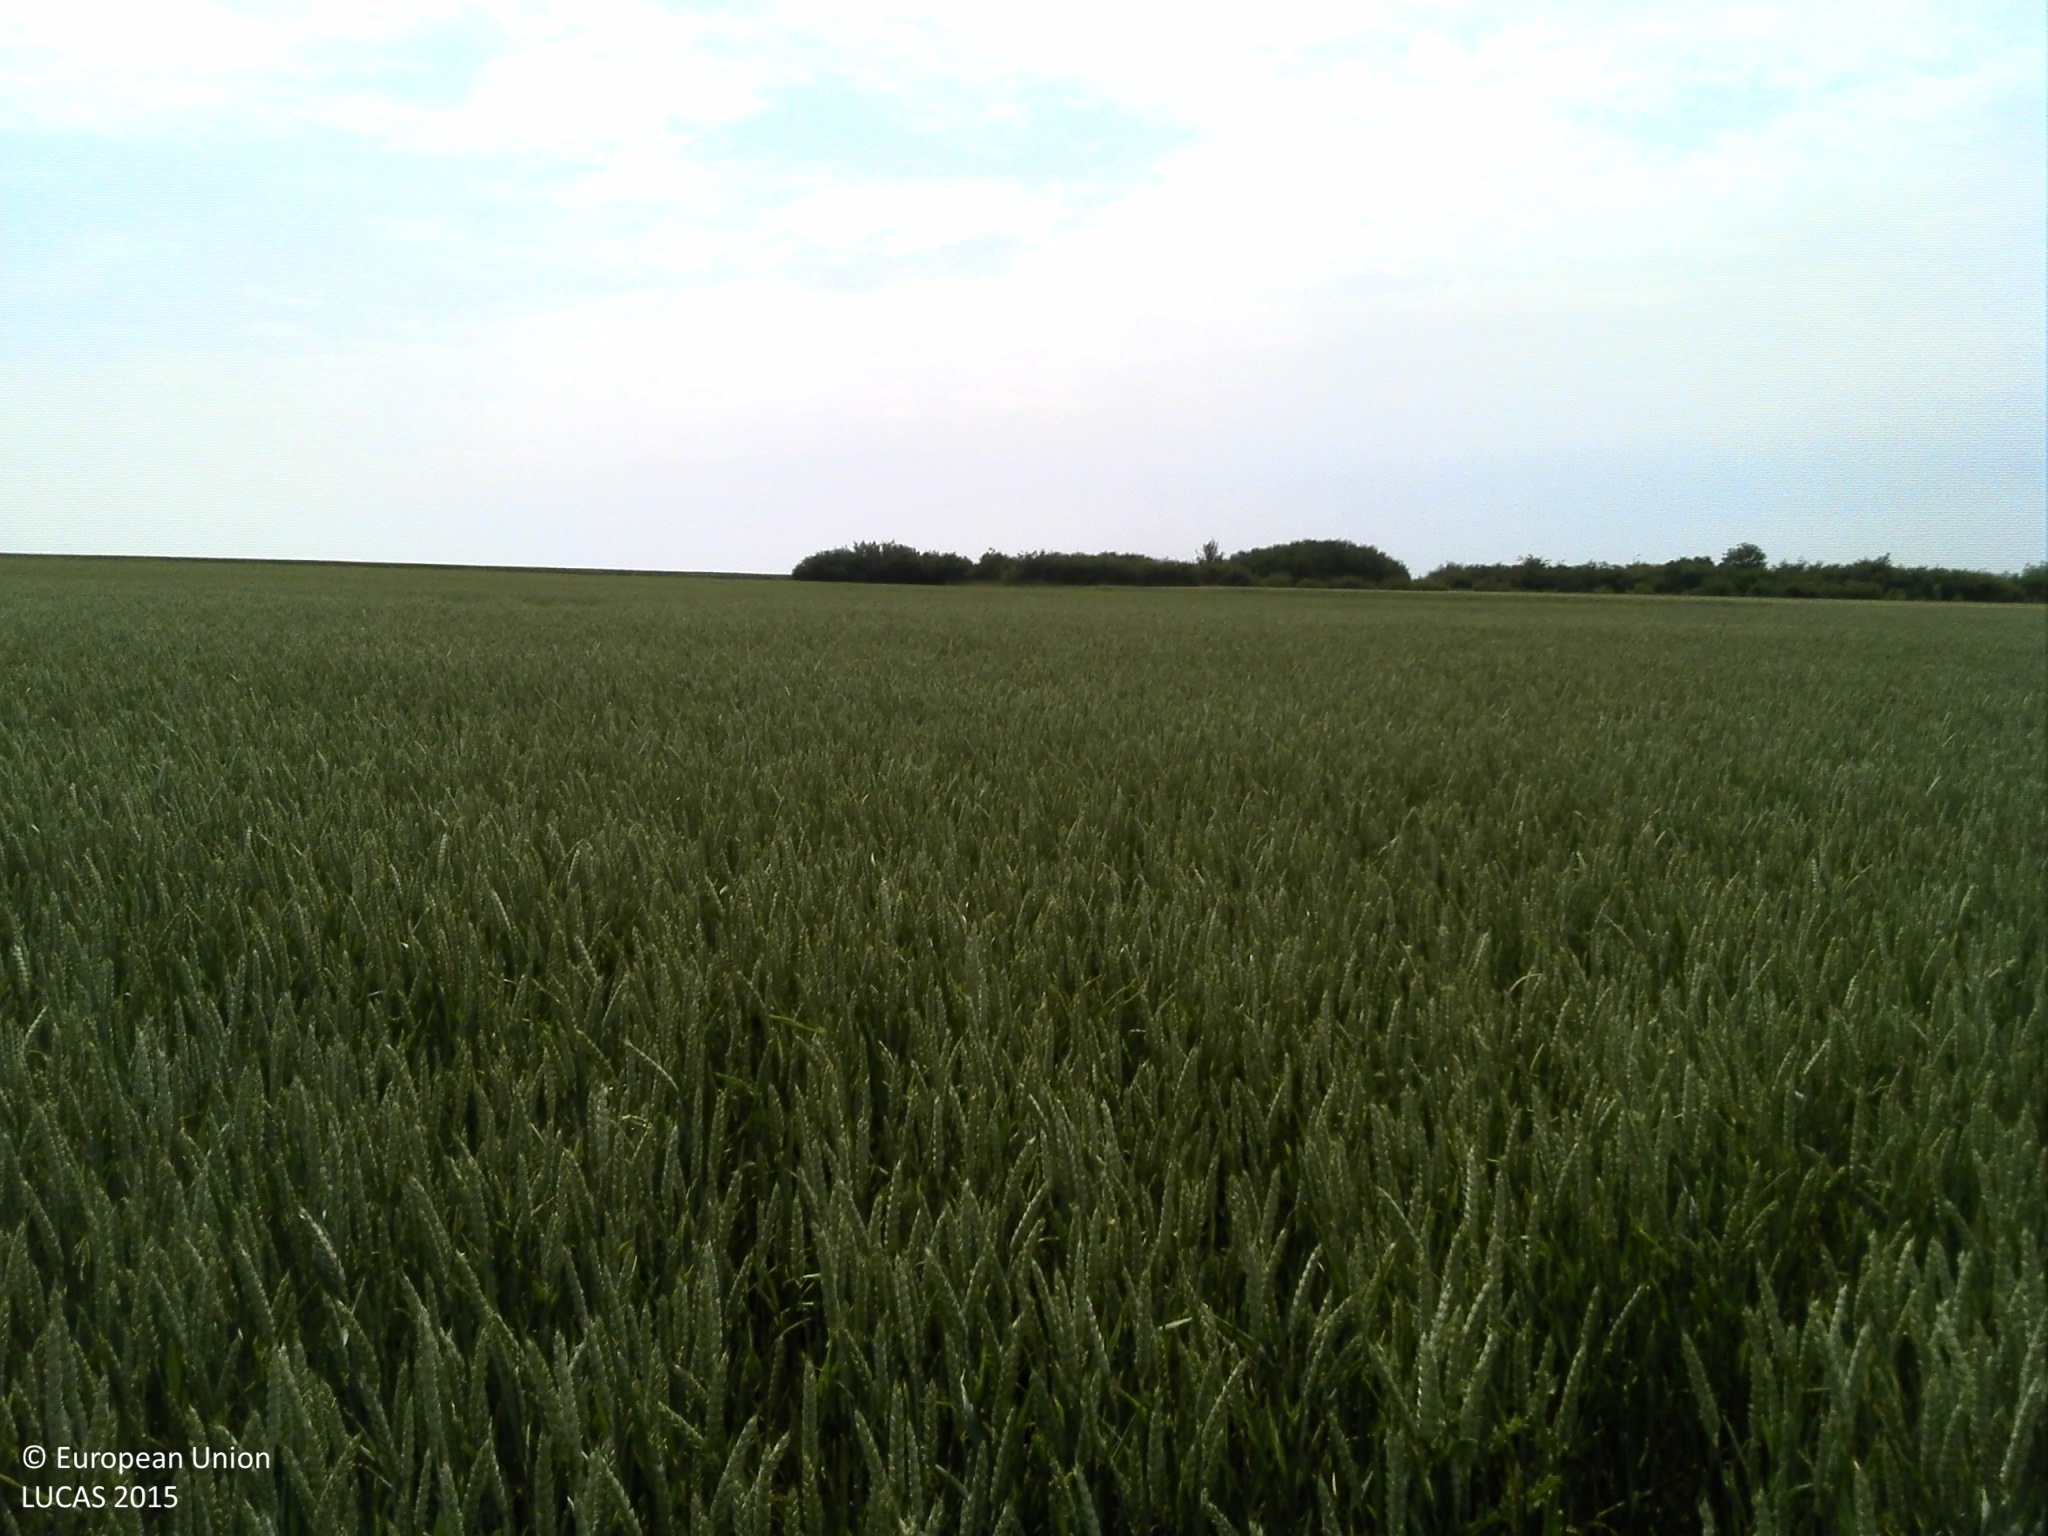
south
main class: Cropland
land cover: Common wheat
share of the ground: > 75 %
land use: Agriculture (excluding fallow land and kitchen gardens)
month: June
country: FR
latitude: 49.2045
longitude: 6.2527
